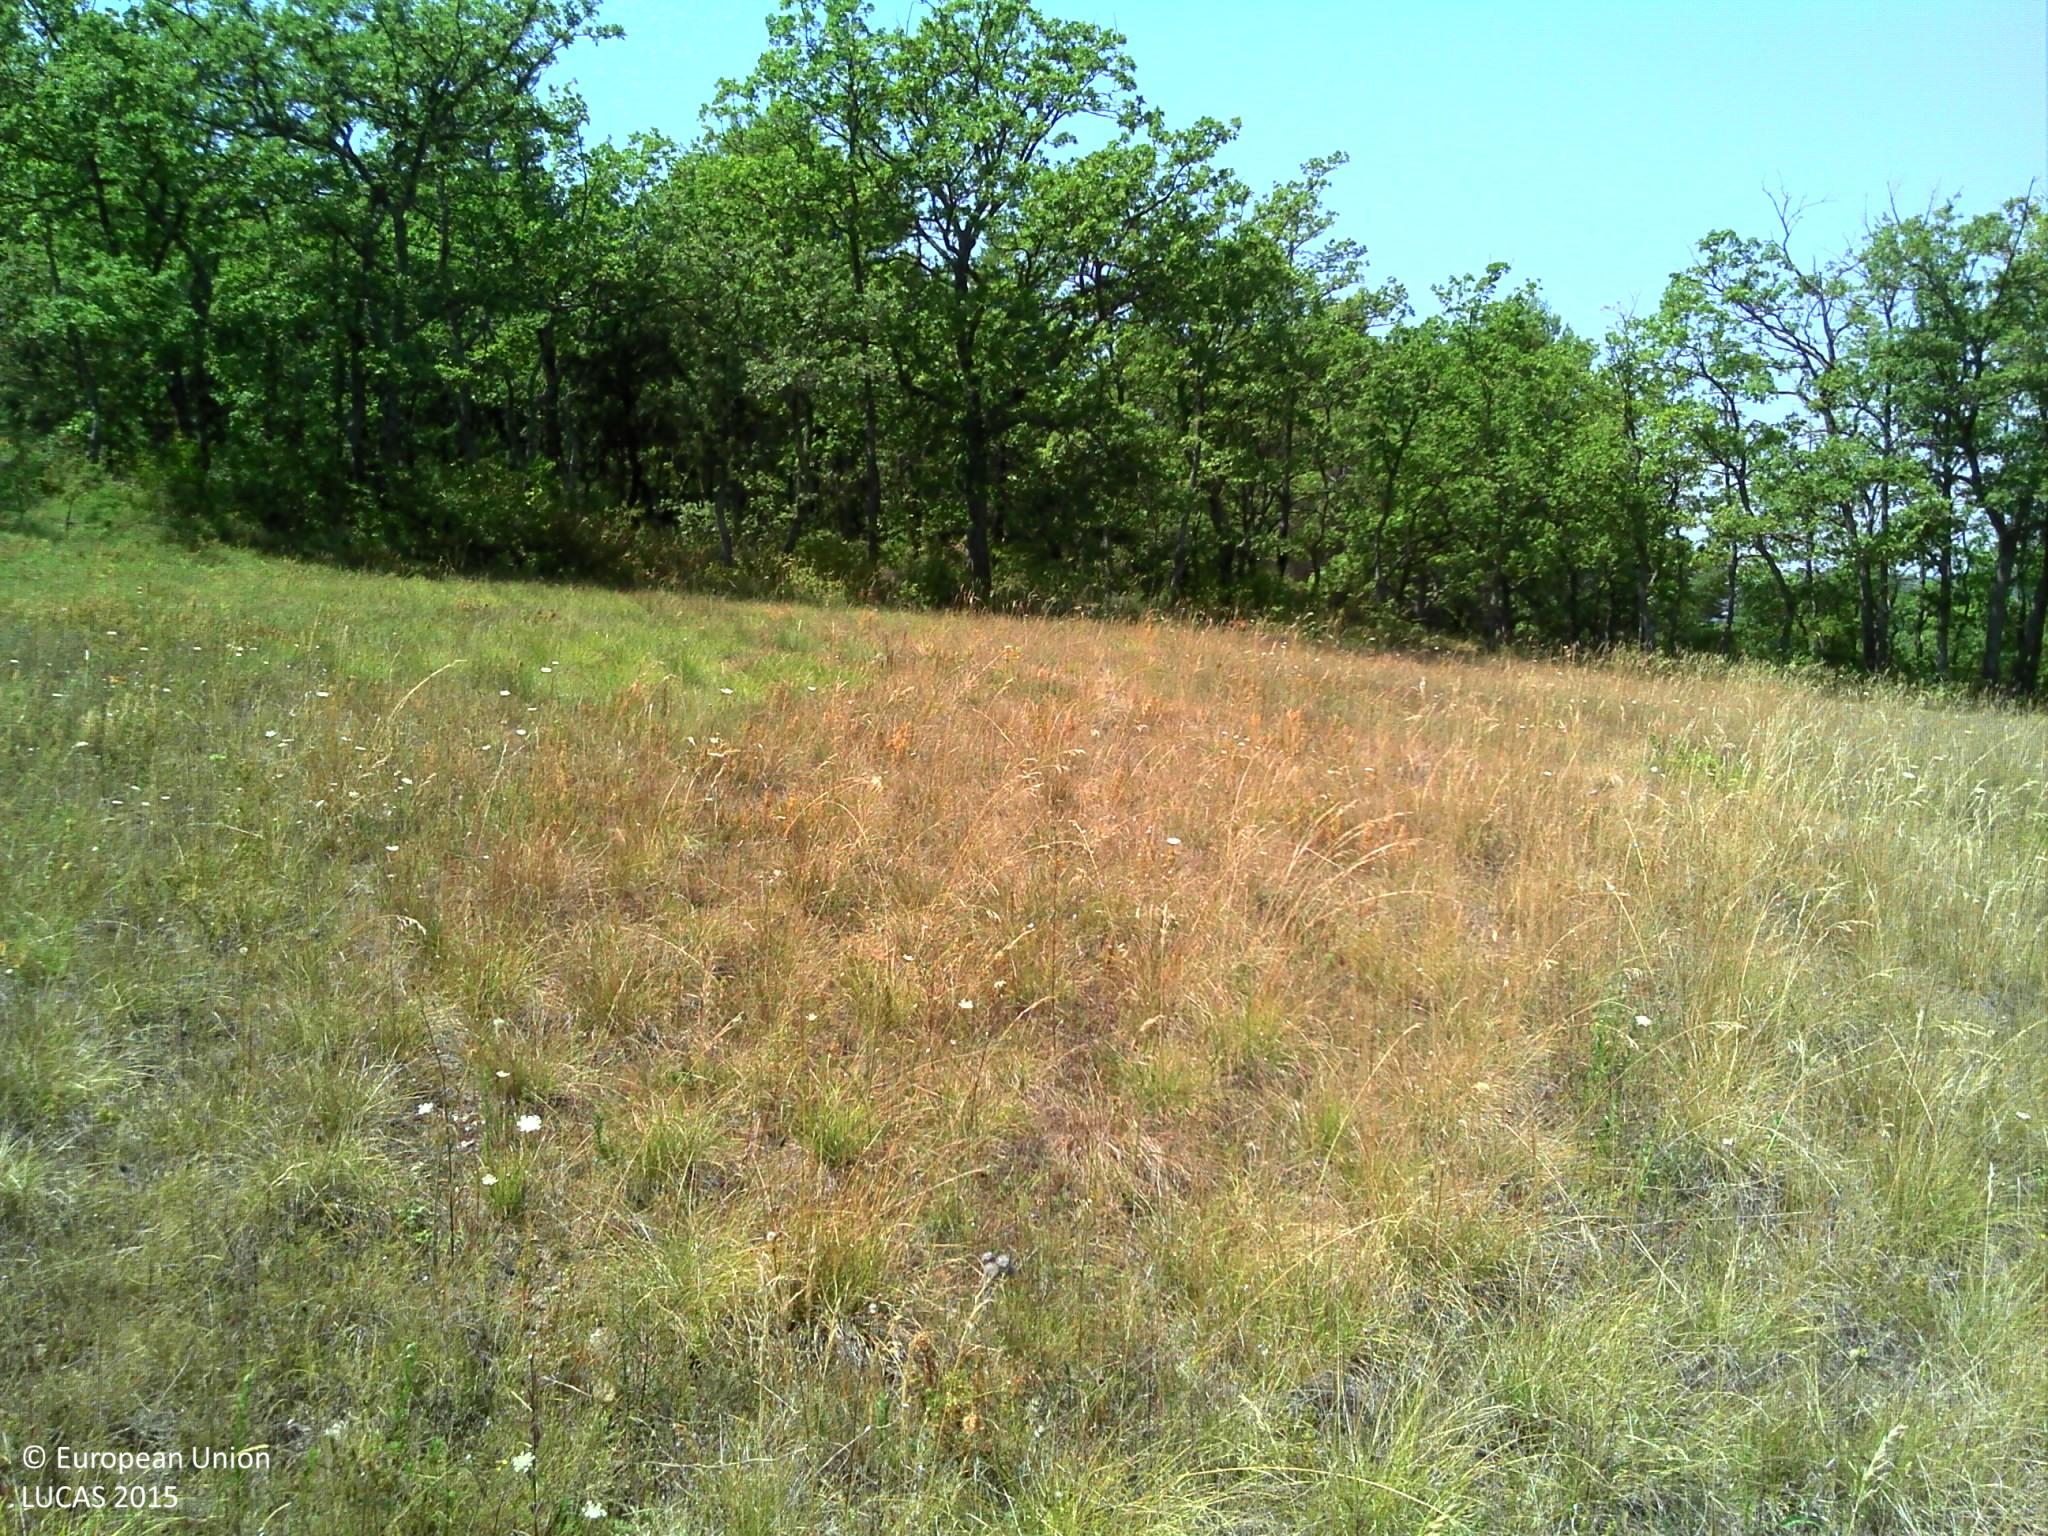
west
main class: Grassland
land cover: Spontaneously vegetated surfaces
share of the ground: > 75 %
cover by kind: herbaceous plants 95 %, lichens and mosses 5 %
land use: Semi-natural and natural areas not in use
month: August
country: FR
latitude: 43.8452
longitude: 5.2697
